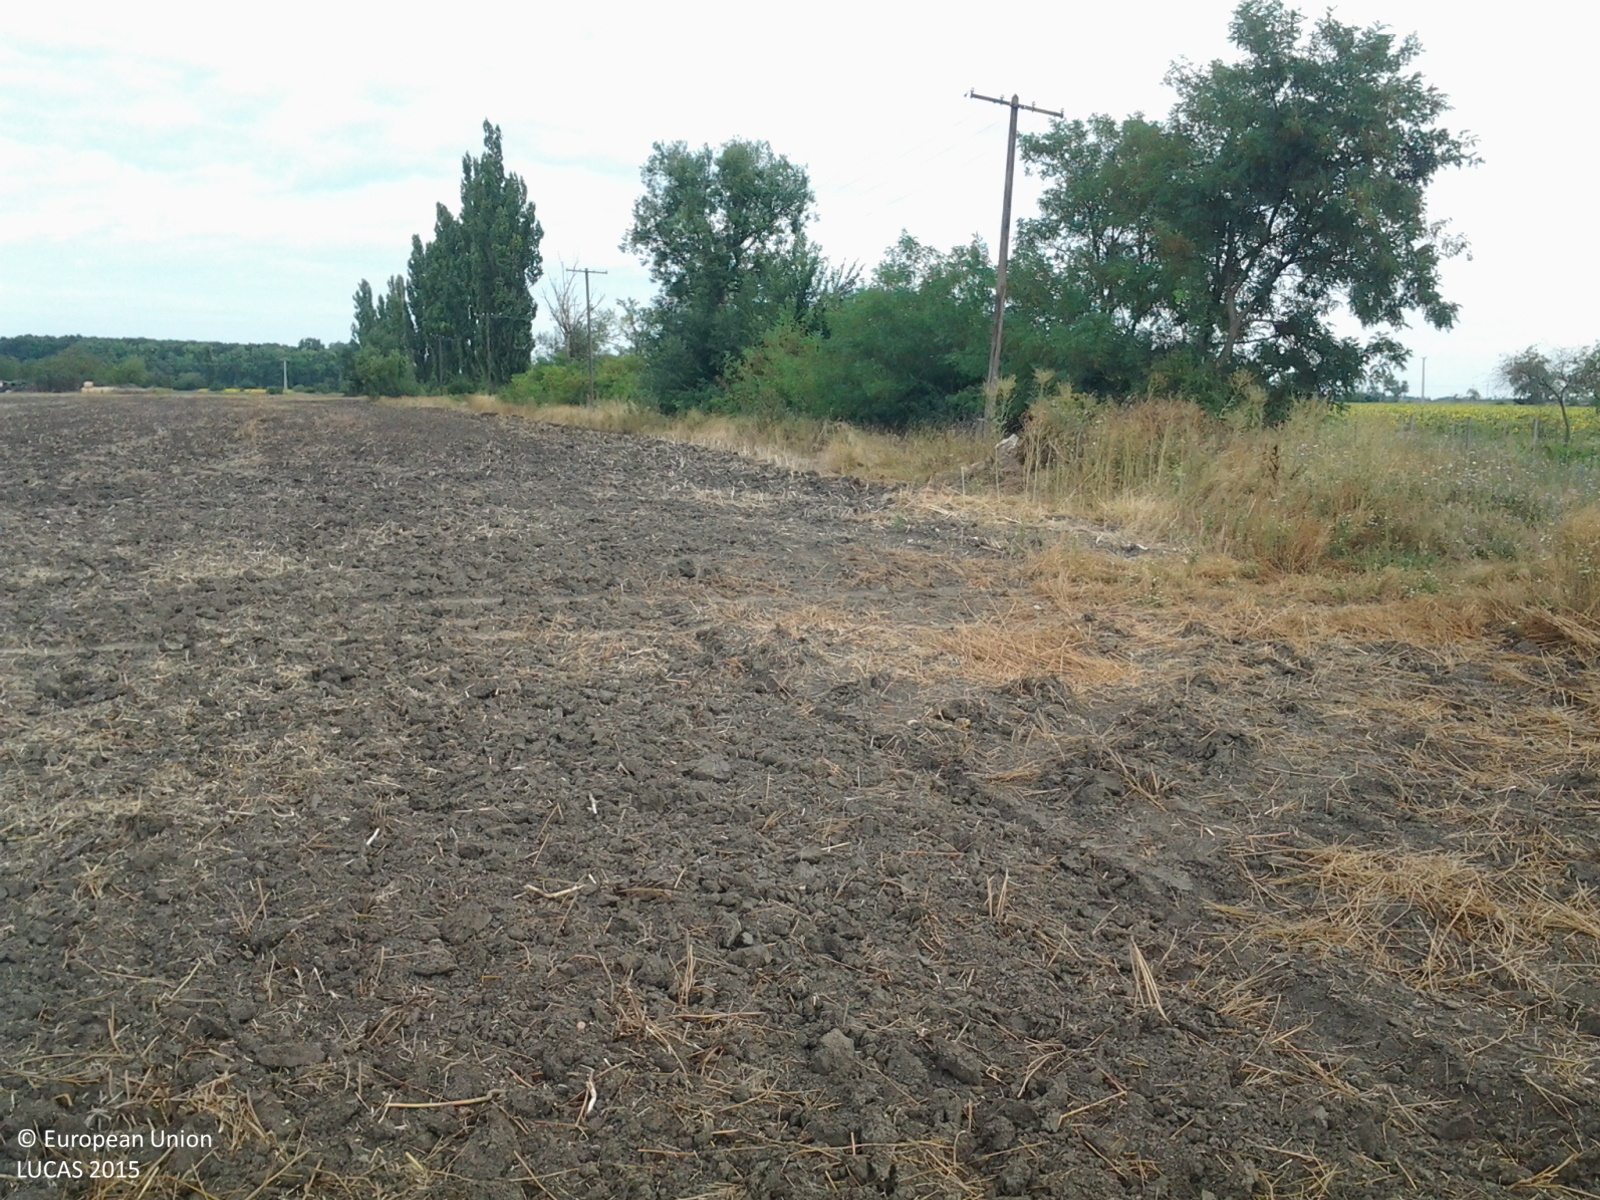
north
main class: Cropland
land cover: Rape and turnip rape
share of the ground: < 10 %
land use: Agriculture (excluding fallow land and kitchen gardens)
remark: Harvested field
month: July
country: HU
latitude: 47.1770
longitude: 20.4929
